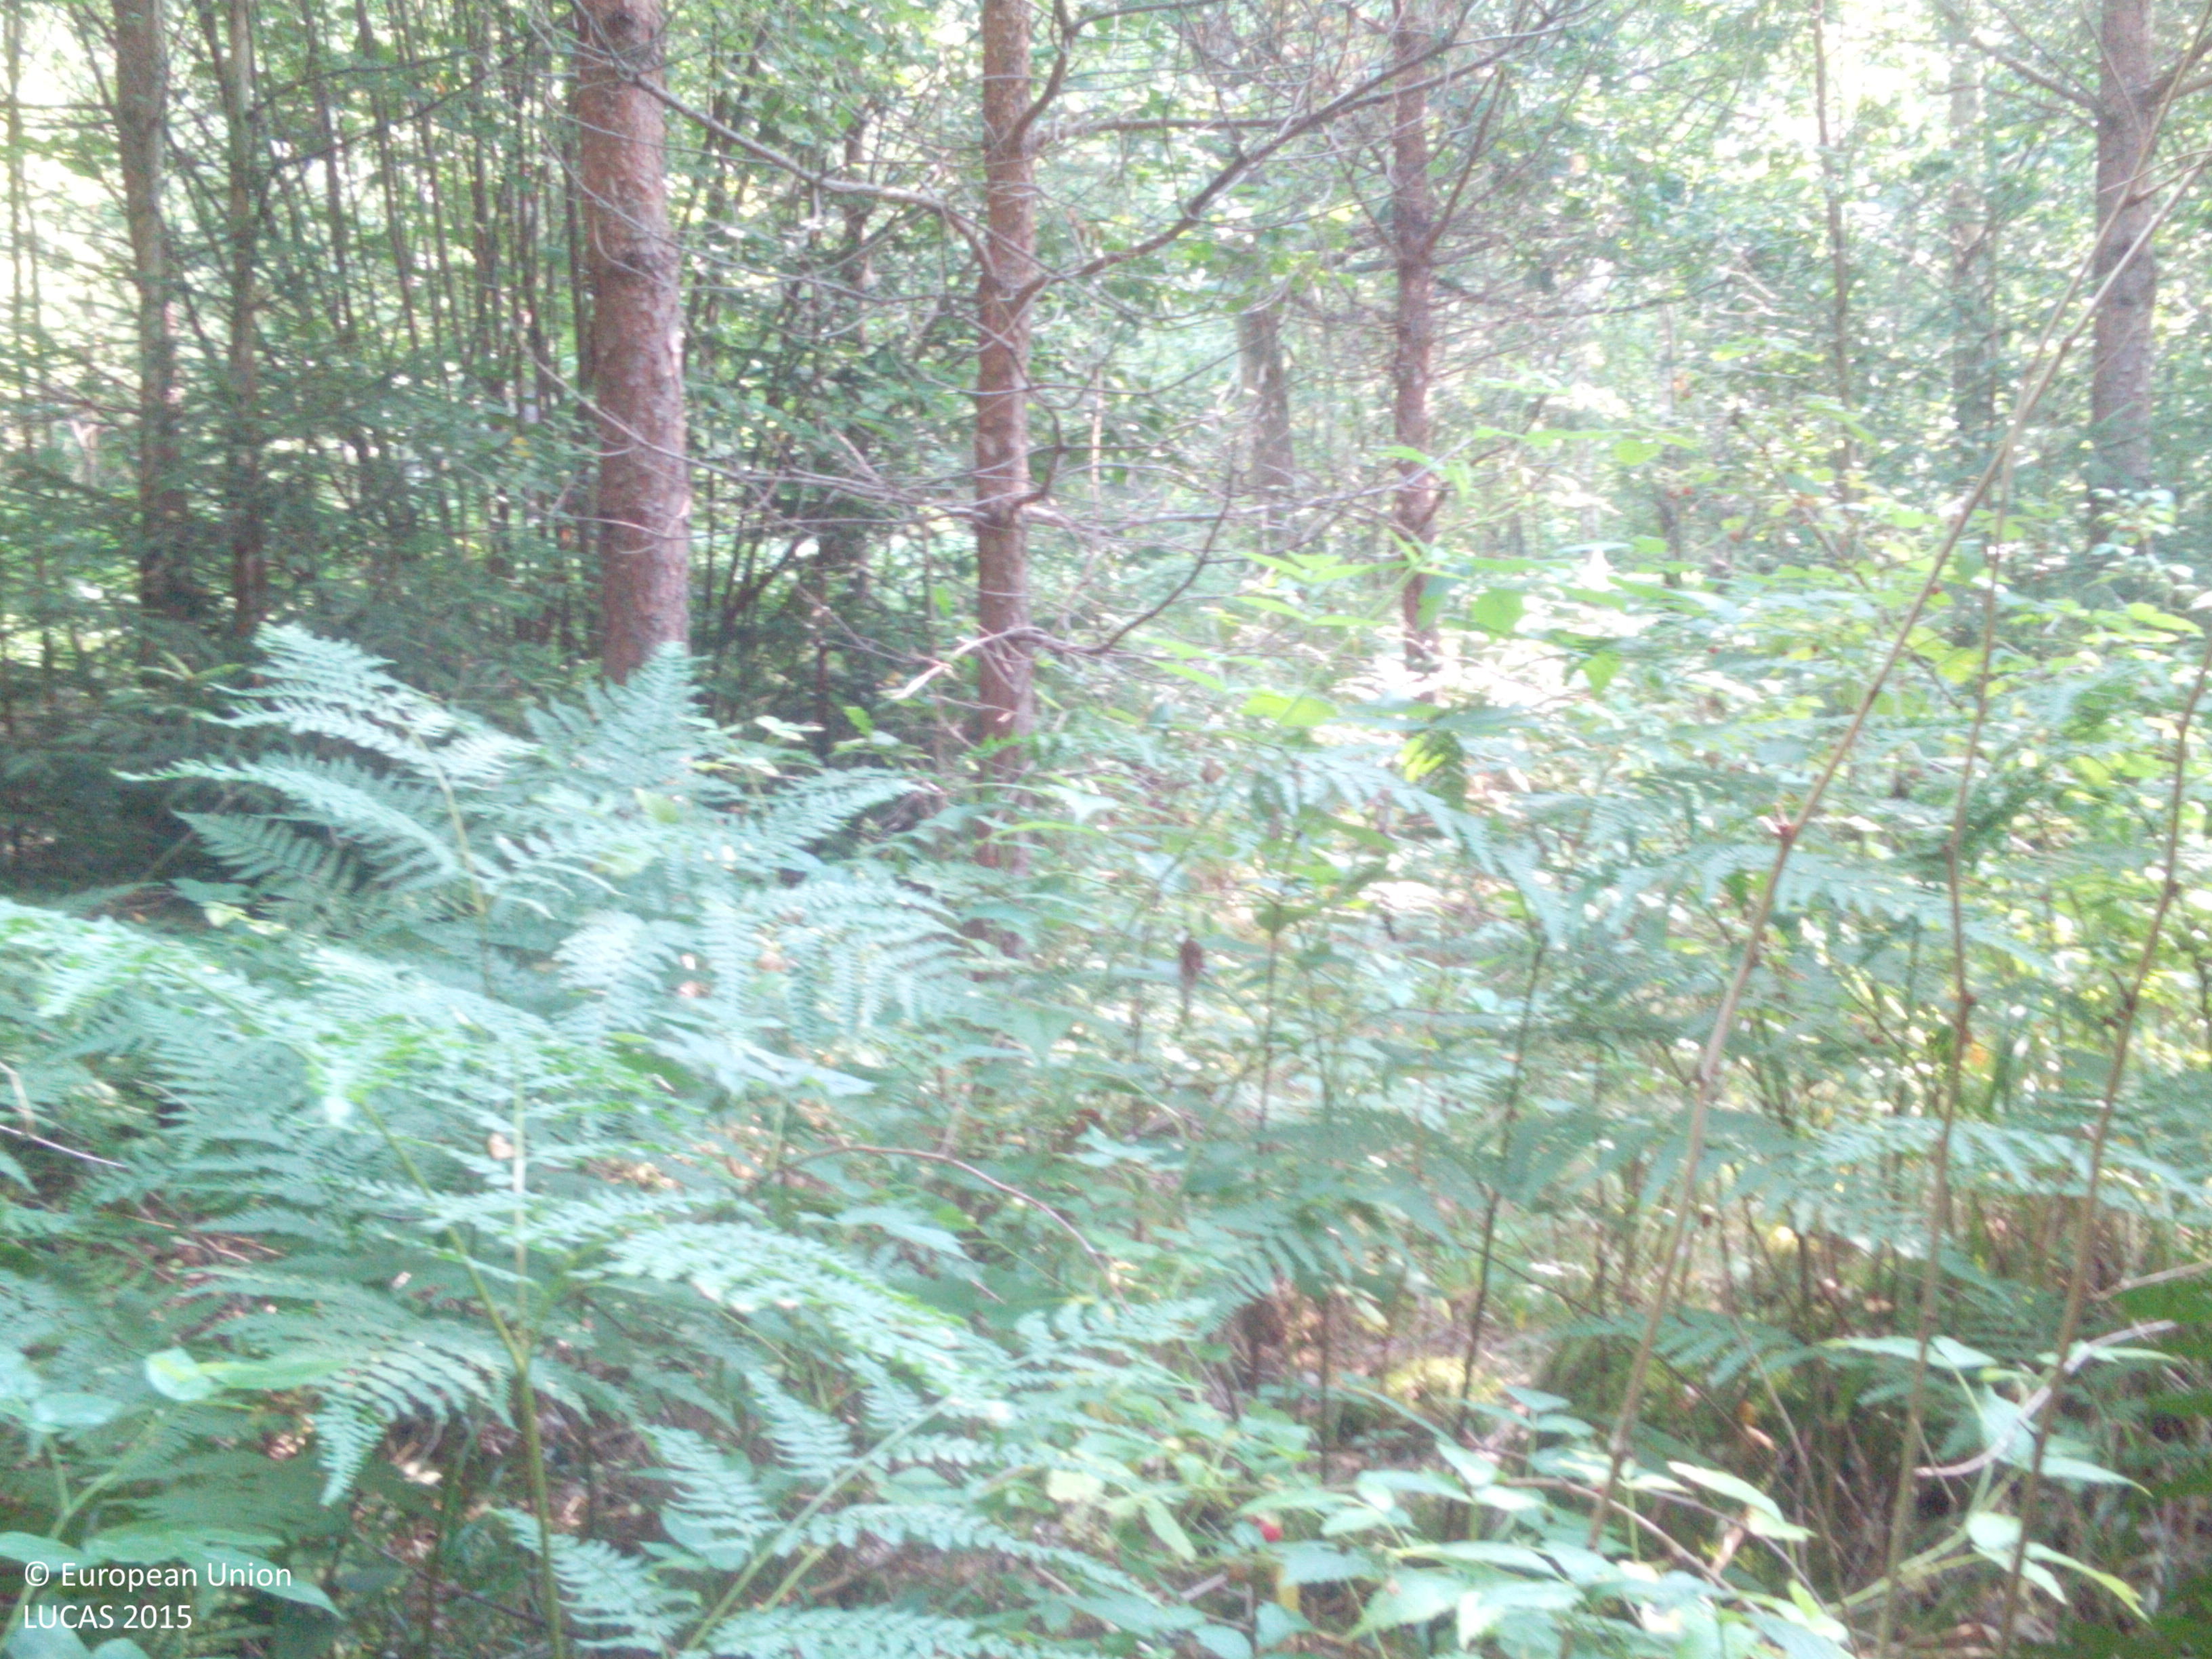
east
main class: Woodland
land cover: Other mixed woodland
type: hemiboreal forest and nemoral coniferous forest and mixed broadleaved-coniferous forest
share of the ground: > 75 %
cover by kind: coniferous forest trees 60 %, broadleaved forest trees 30 %, herbaceous plants 10 %
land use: Forestry
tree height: > 5 m
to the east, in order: Other mixed woodland; Grassland with sparse tree/shrub cover; Tracks; Spontaneously vegetated surfaces; Spruce dominated coniferous woodland; Grassland without tree/shrub cover; Grassland with sparse tree/shrub cover; Grassland without tree/shrub cover
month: August
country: LV
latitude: 57.0249
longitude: 21.7899
